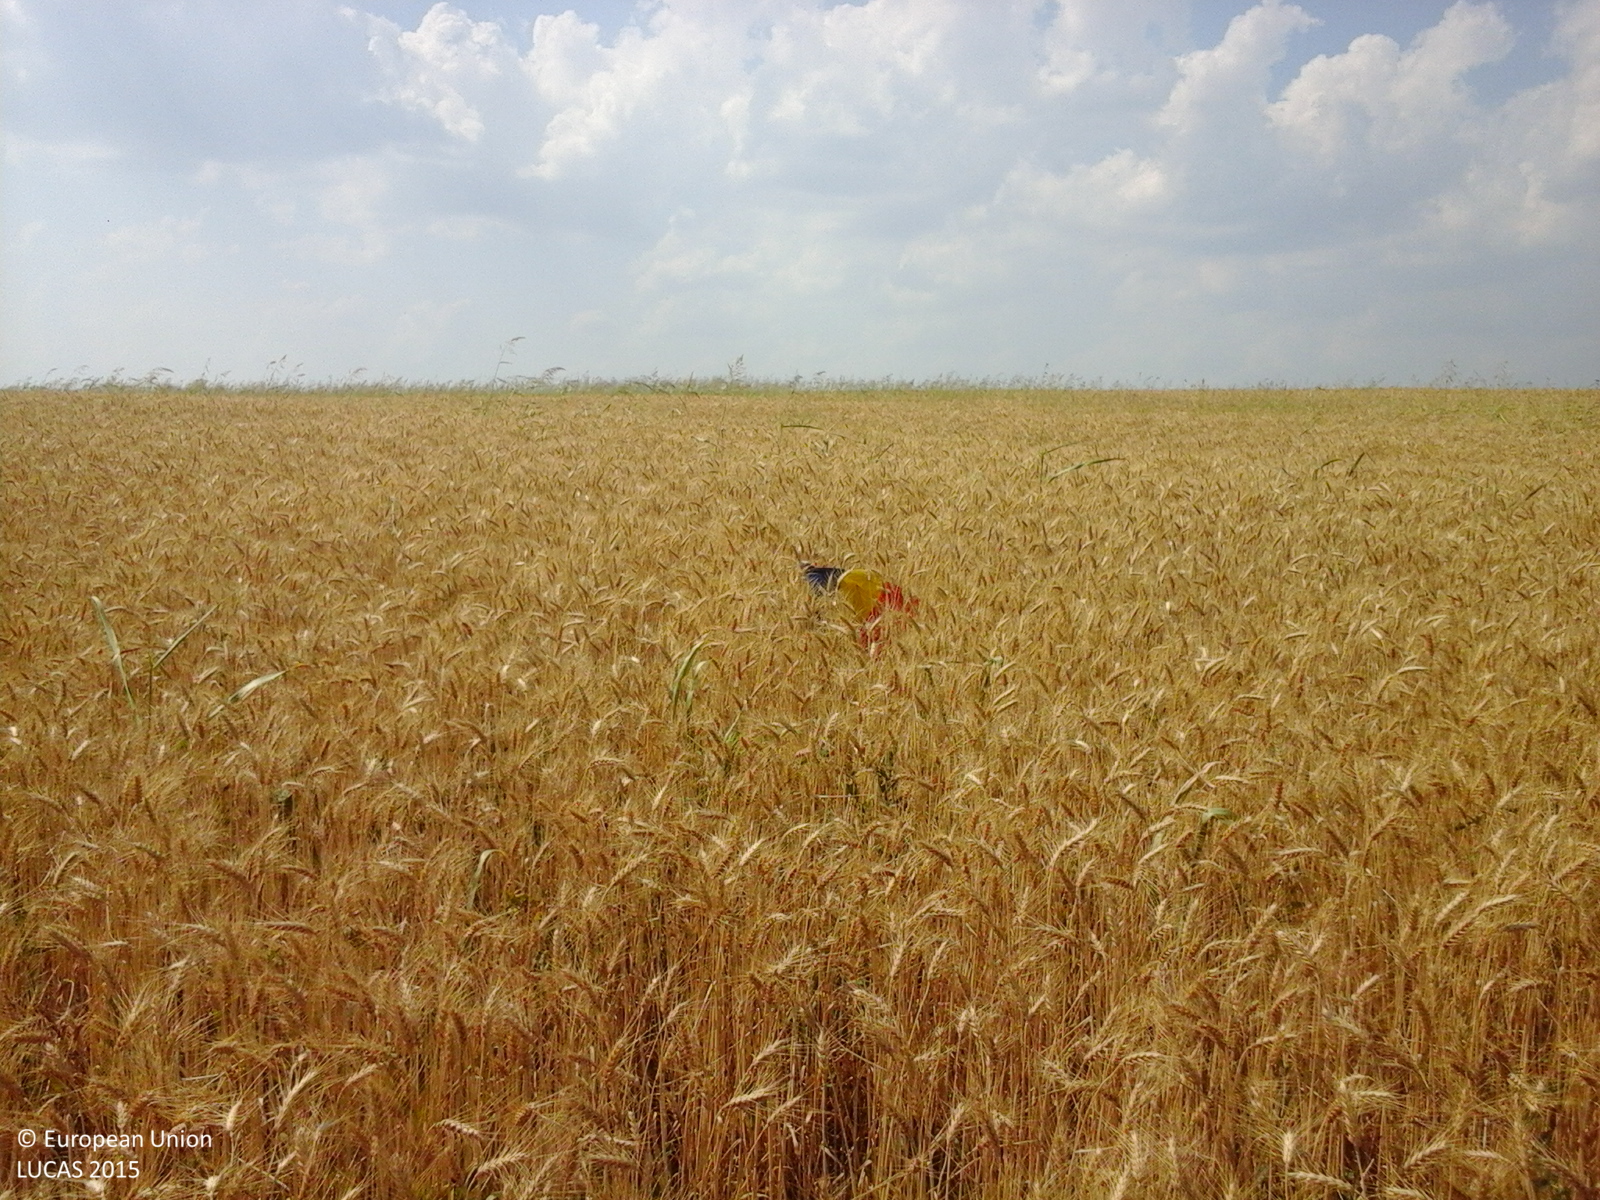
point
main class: Cropland
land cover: Durum wheat
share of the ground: > 75 %
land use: Agriculture (excluding fallow land and kitchen gardens)
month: July
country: RO
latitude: 45.9265
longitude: 28.0343
